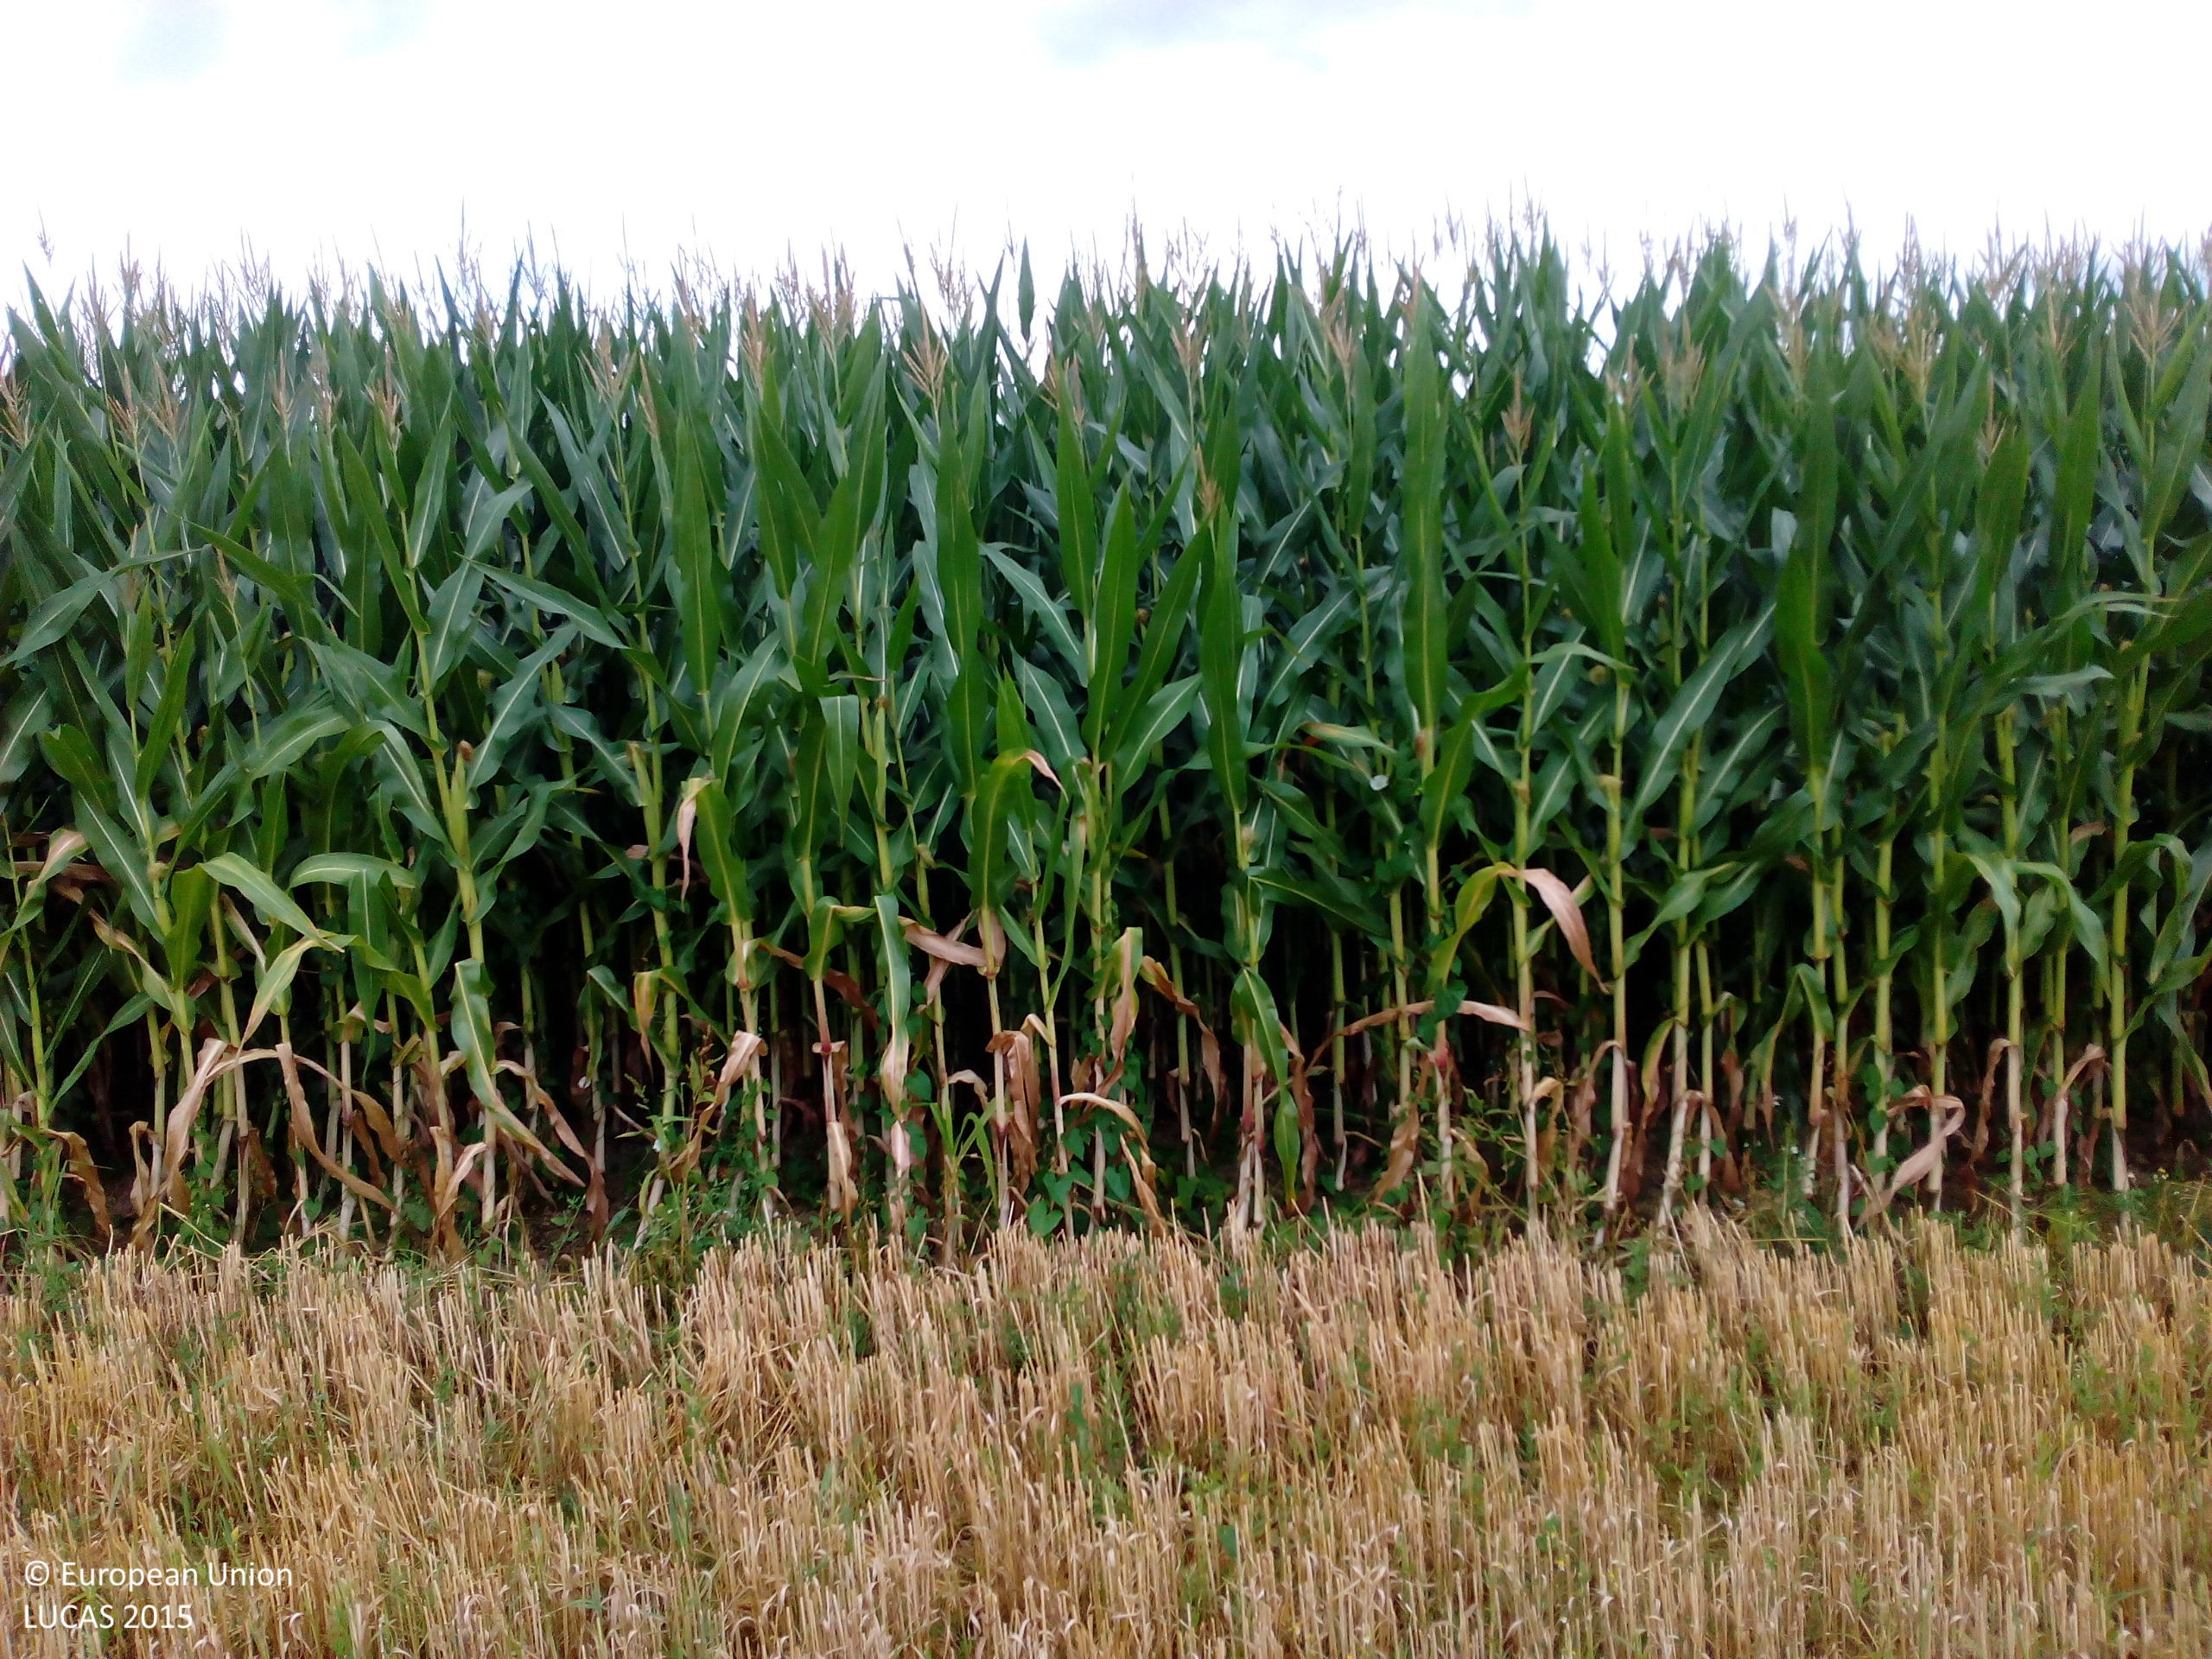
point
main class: Cropland
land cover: Maize
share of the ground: > 75 %
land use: Agriculture (excluding fallow land and kitchen gardens)
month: July
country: DE
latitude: 48.8688
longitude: 12.9306
